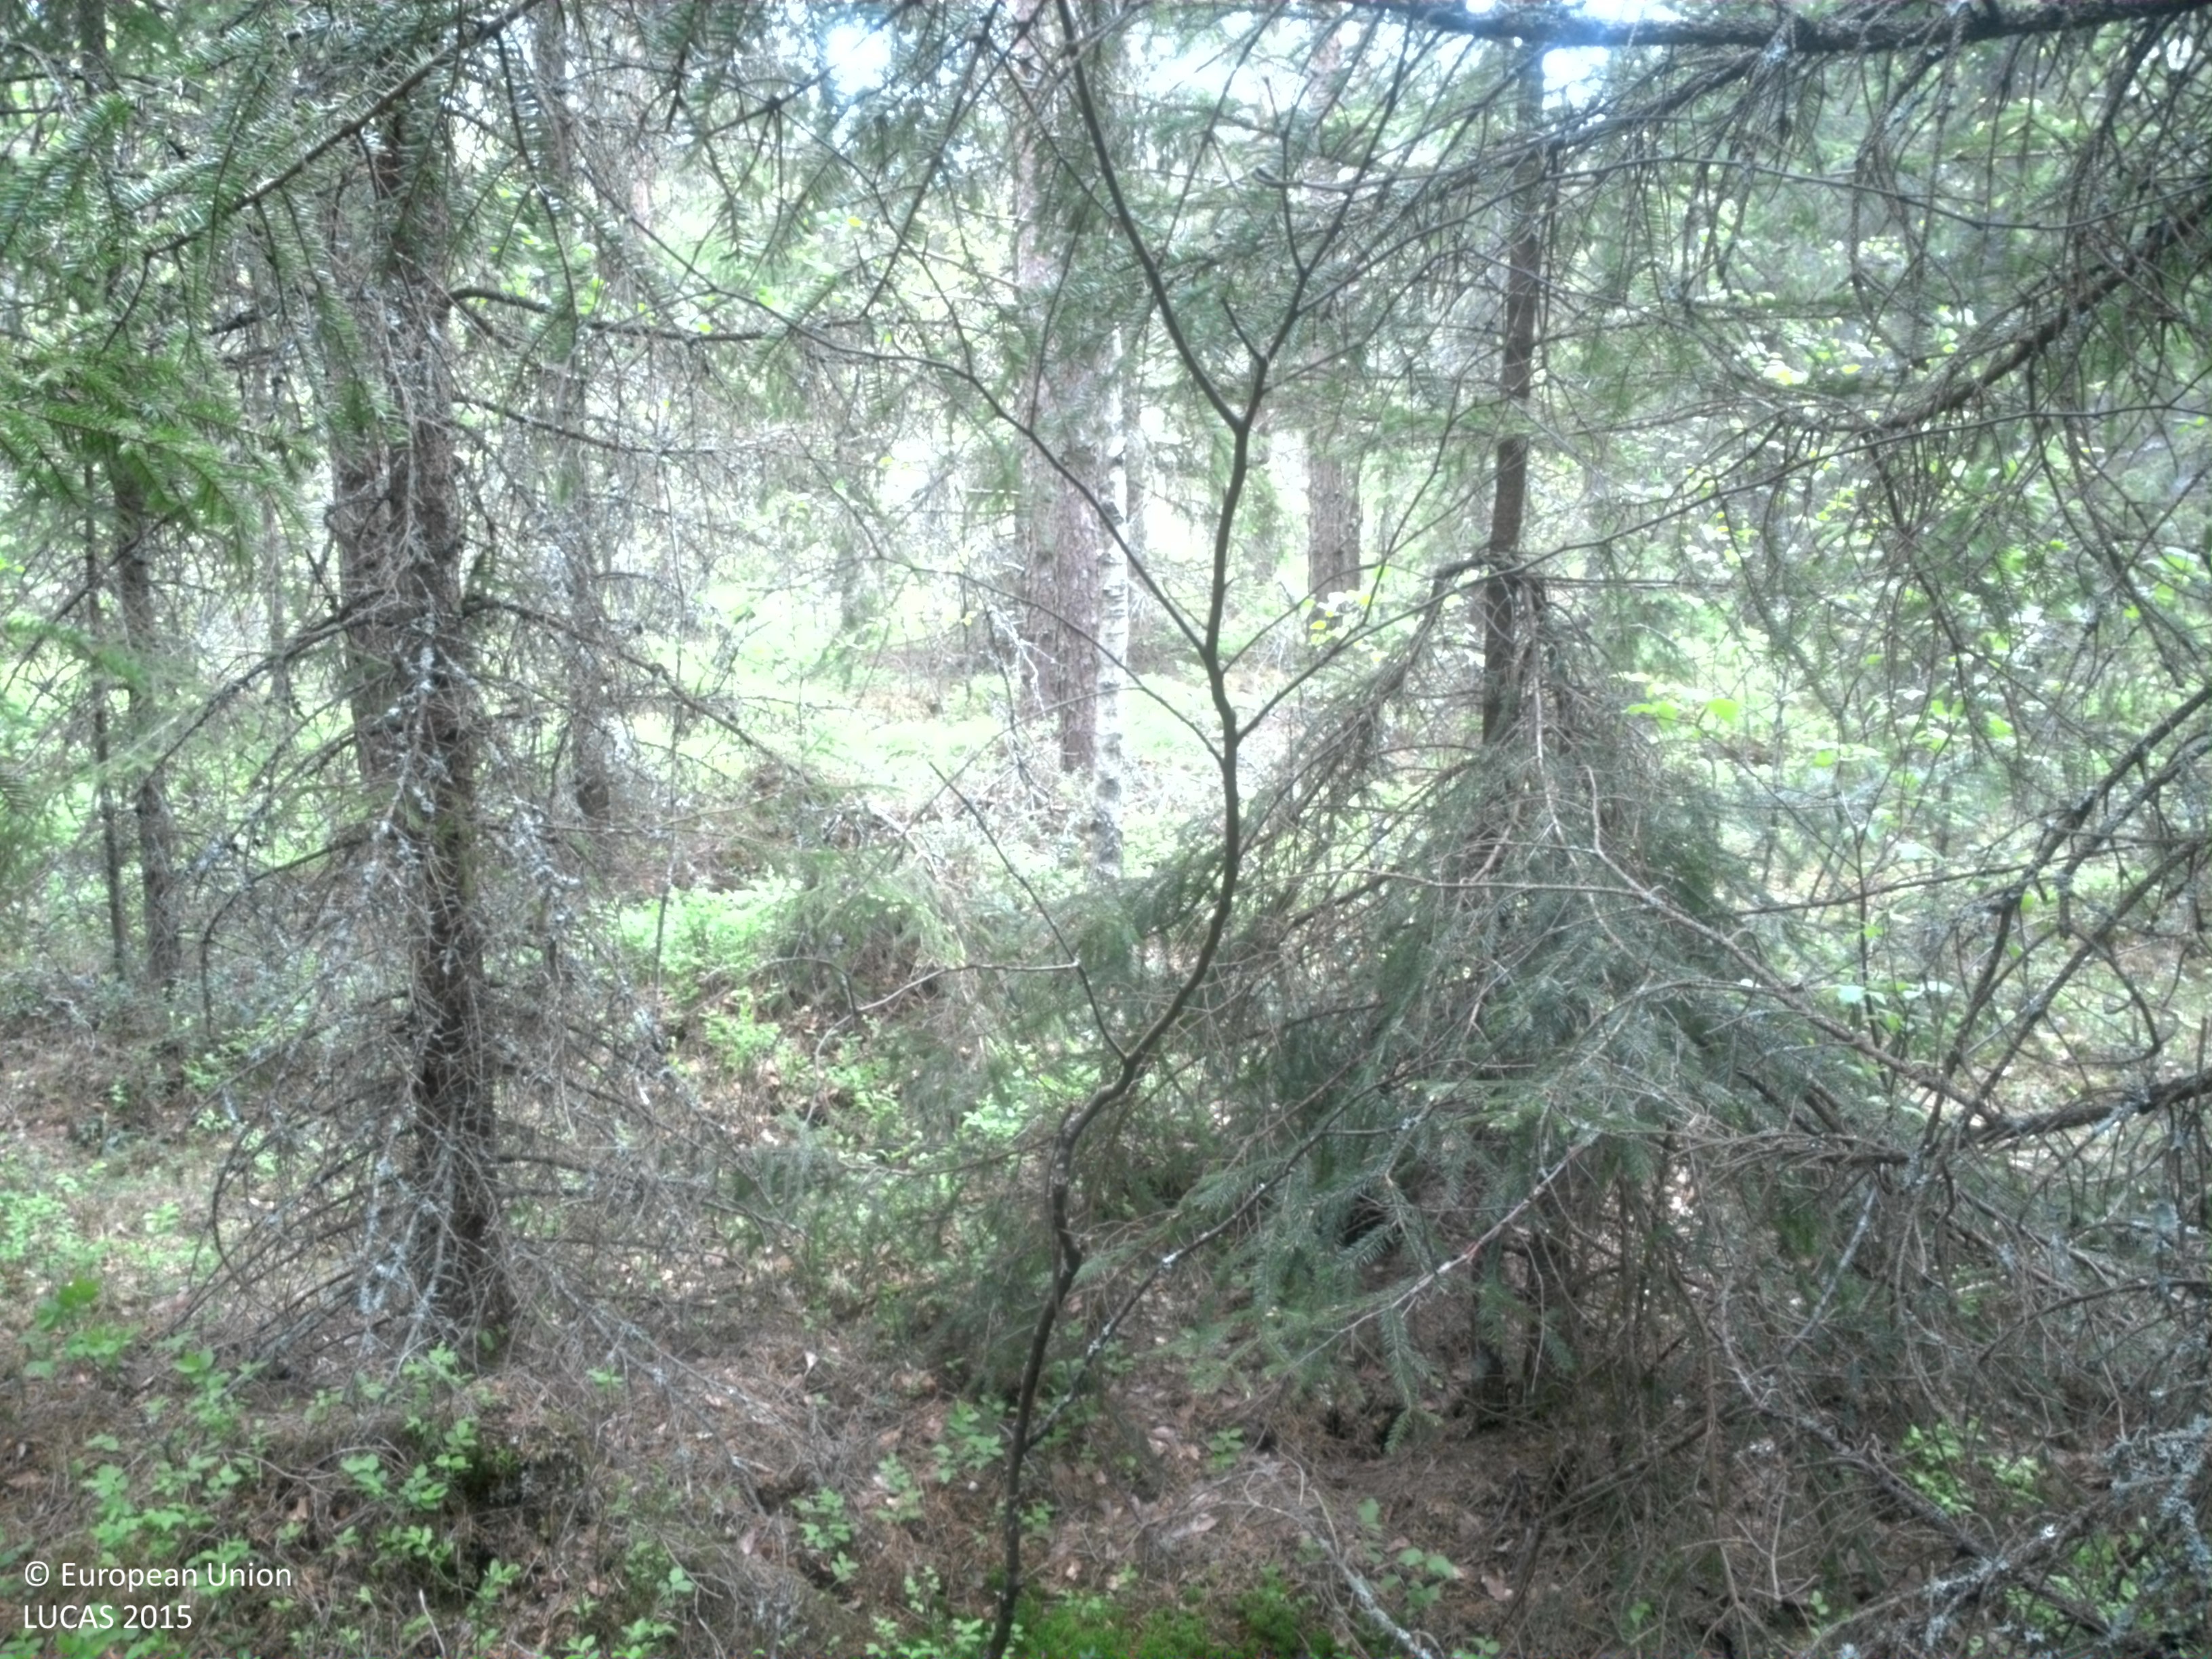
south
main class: Woodland
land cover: Spruce dominated coniferous woodland
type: boreal forest
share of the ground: > 75 %
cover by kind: coniferous forest trees 65 %, broadleaved forest trees 10 %, shrubs 10 %, lichens and mosses 10 %, herbaceous plants 5 %
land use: Forestry
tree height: > 5 m
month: June
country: SE
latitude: 59.5260
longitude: 14.1101
